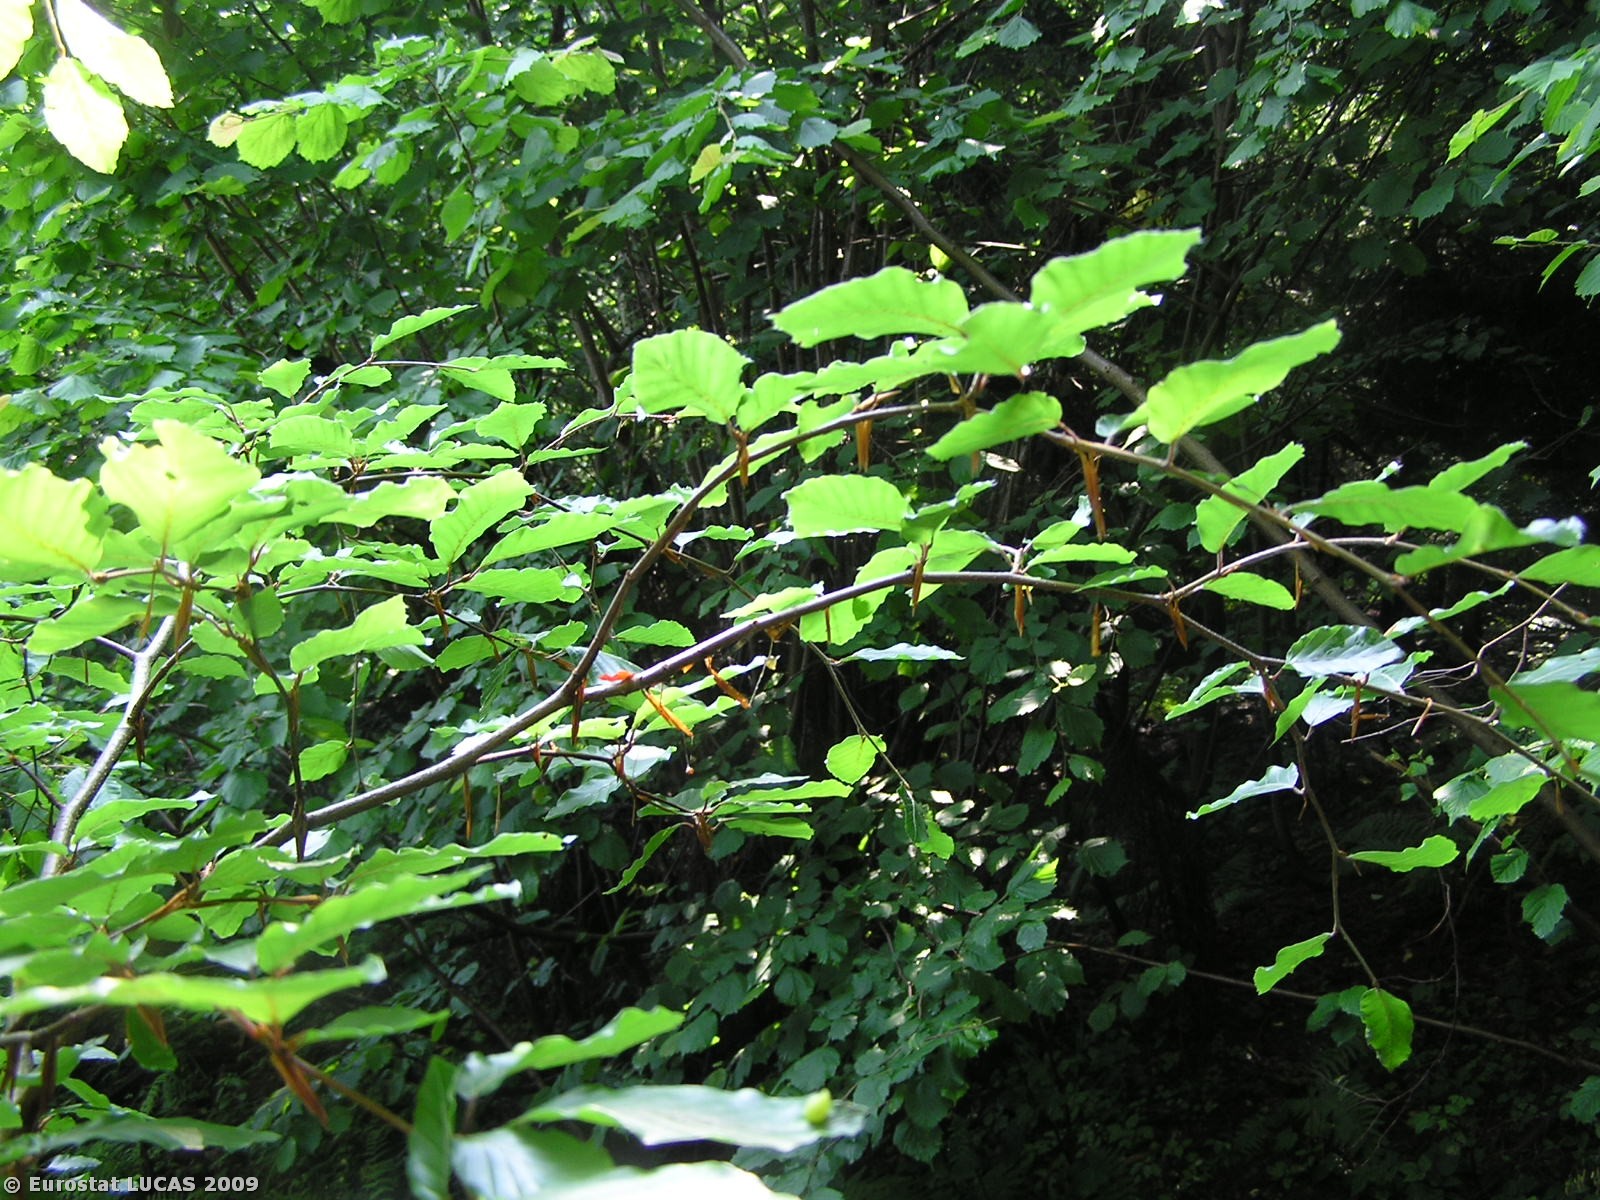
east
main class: Woodland
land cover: Mixed woodland
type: hemiboreal forest and nemoral coniferous forest and mixed broadleaved-coniferous forest
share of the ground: > 75 %
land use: Forestry
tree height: > 5 m
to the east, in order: Mixed woodland; Tracks; Mixed woodland; Tracks; Mixed woodland; Ditches and canals; Mixed woodland
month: June
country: CZ
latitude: 50.2647
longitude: 17.4615
